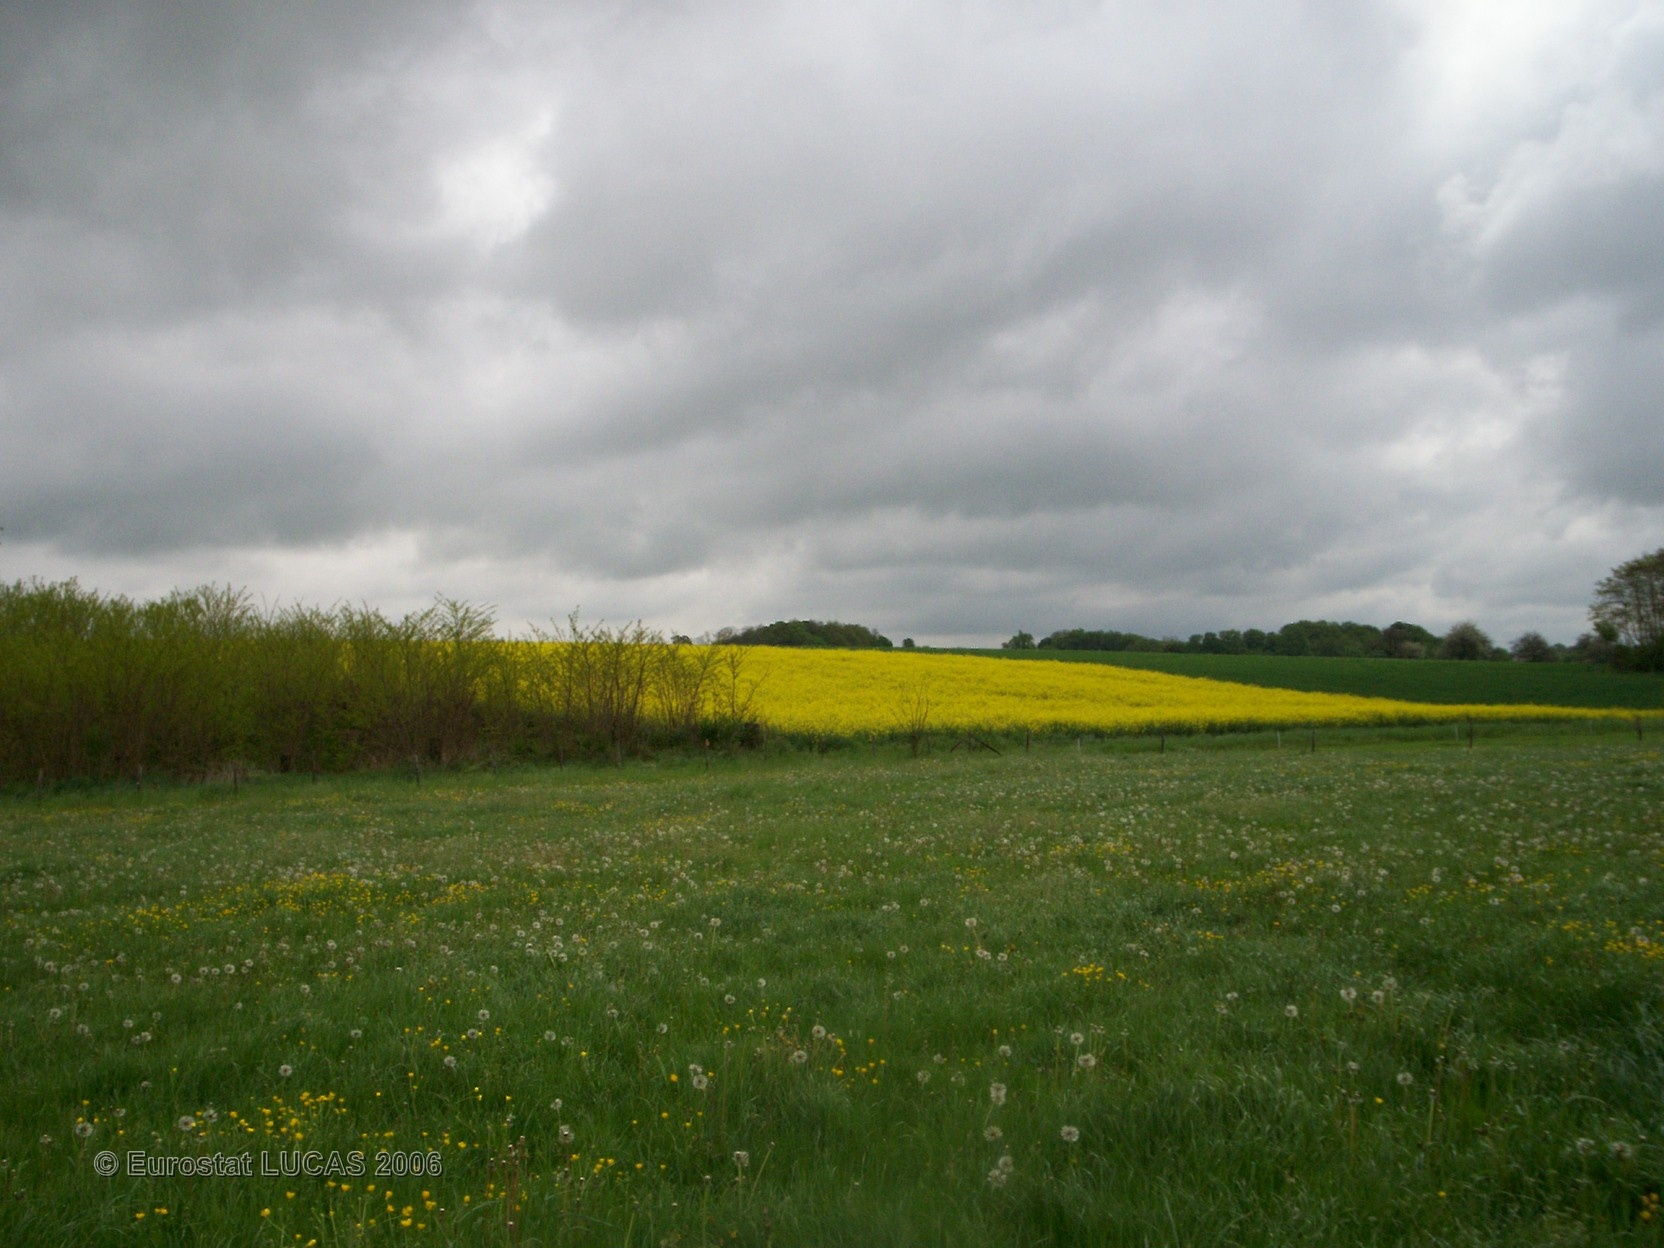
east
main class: Grassland
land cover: Grassland without tree/shrub cover
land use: Agriculture (excluding fallow land and kitchen gardens)
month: May
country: FR
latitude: 48.0144
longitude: 2.9275
